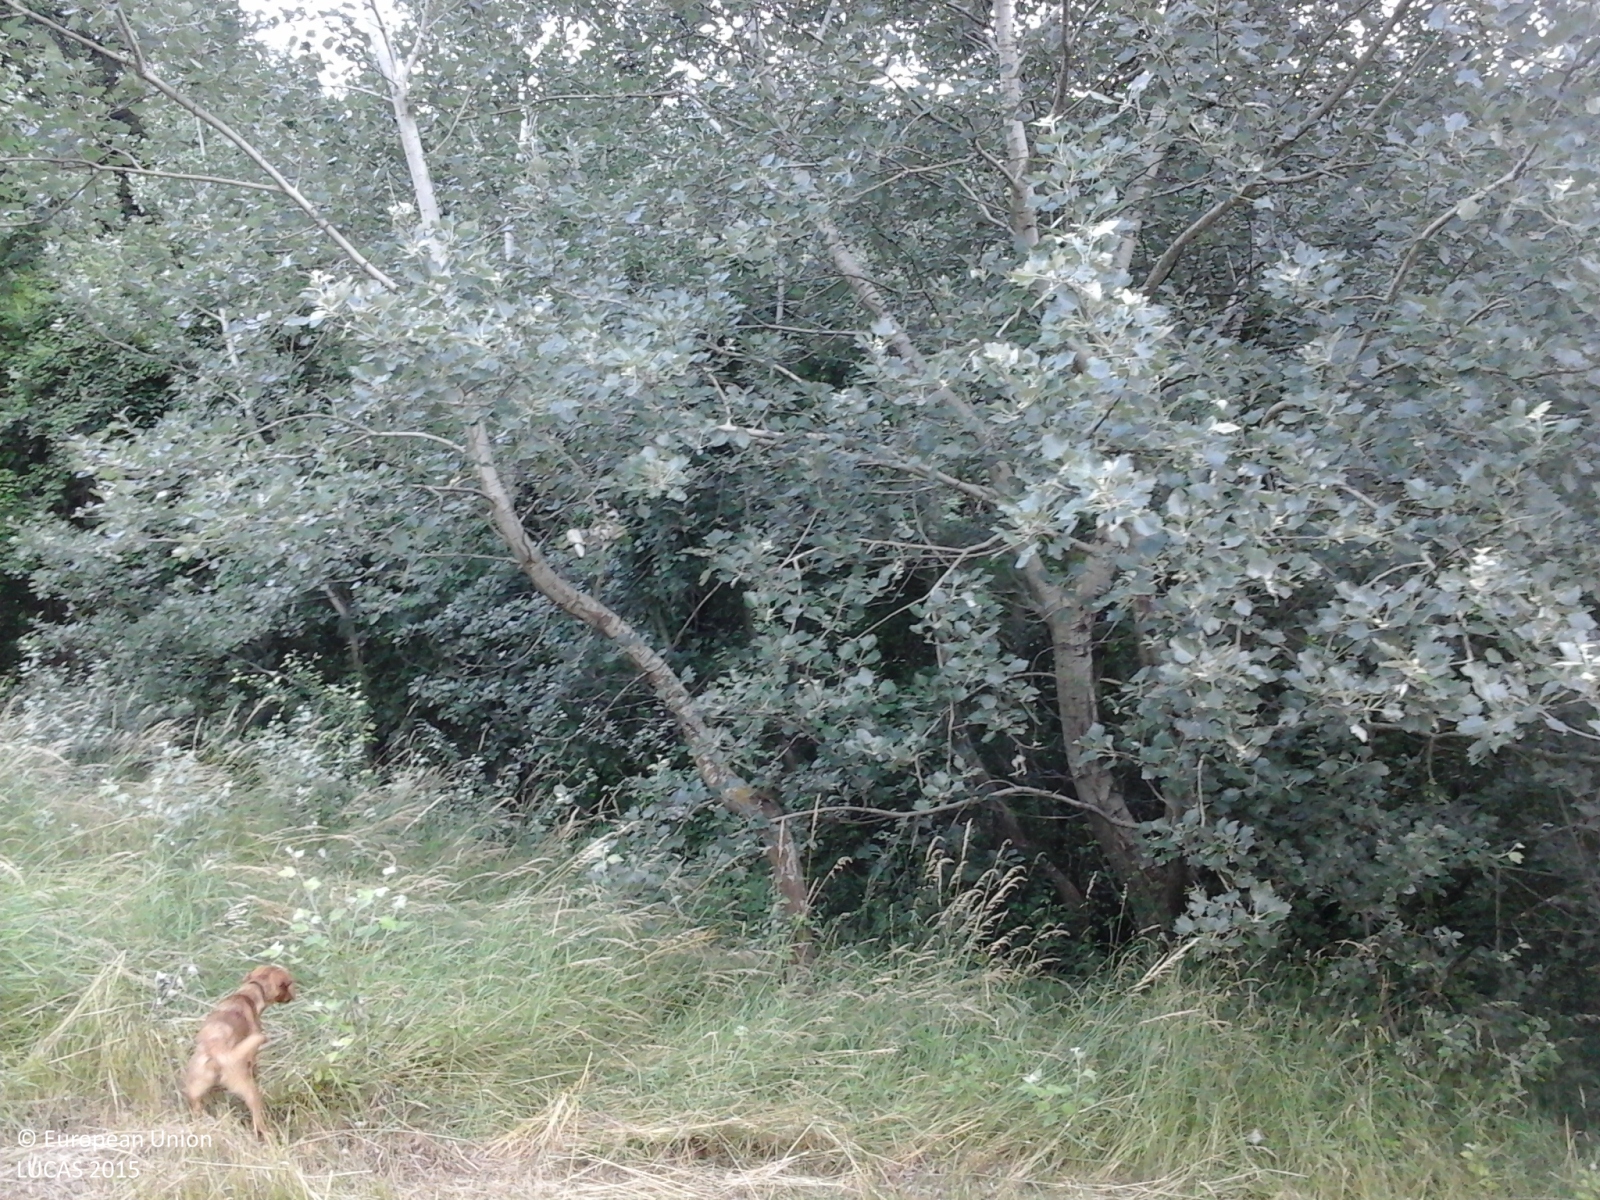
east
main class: Grassland
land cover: Grassland without tree/shrub cover
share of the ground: > 75 %
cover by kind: herbaceous plants 100 %
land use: Agriculture (excluding fallow land and kitchen gardens)
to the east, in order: Grassland without tree/shrub cover; Broadleaved woodland
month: June
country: IT
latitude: 45.6273
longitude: 10.8324
